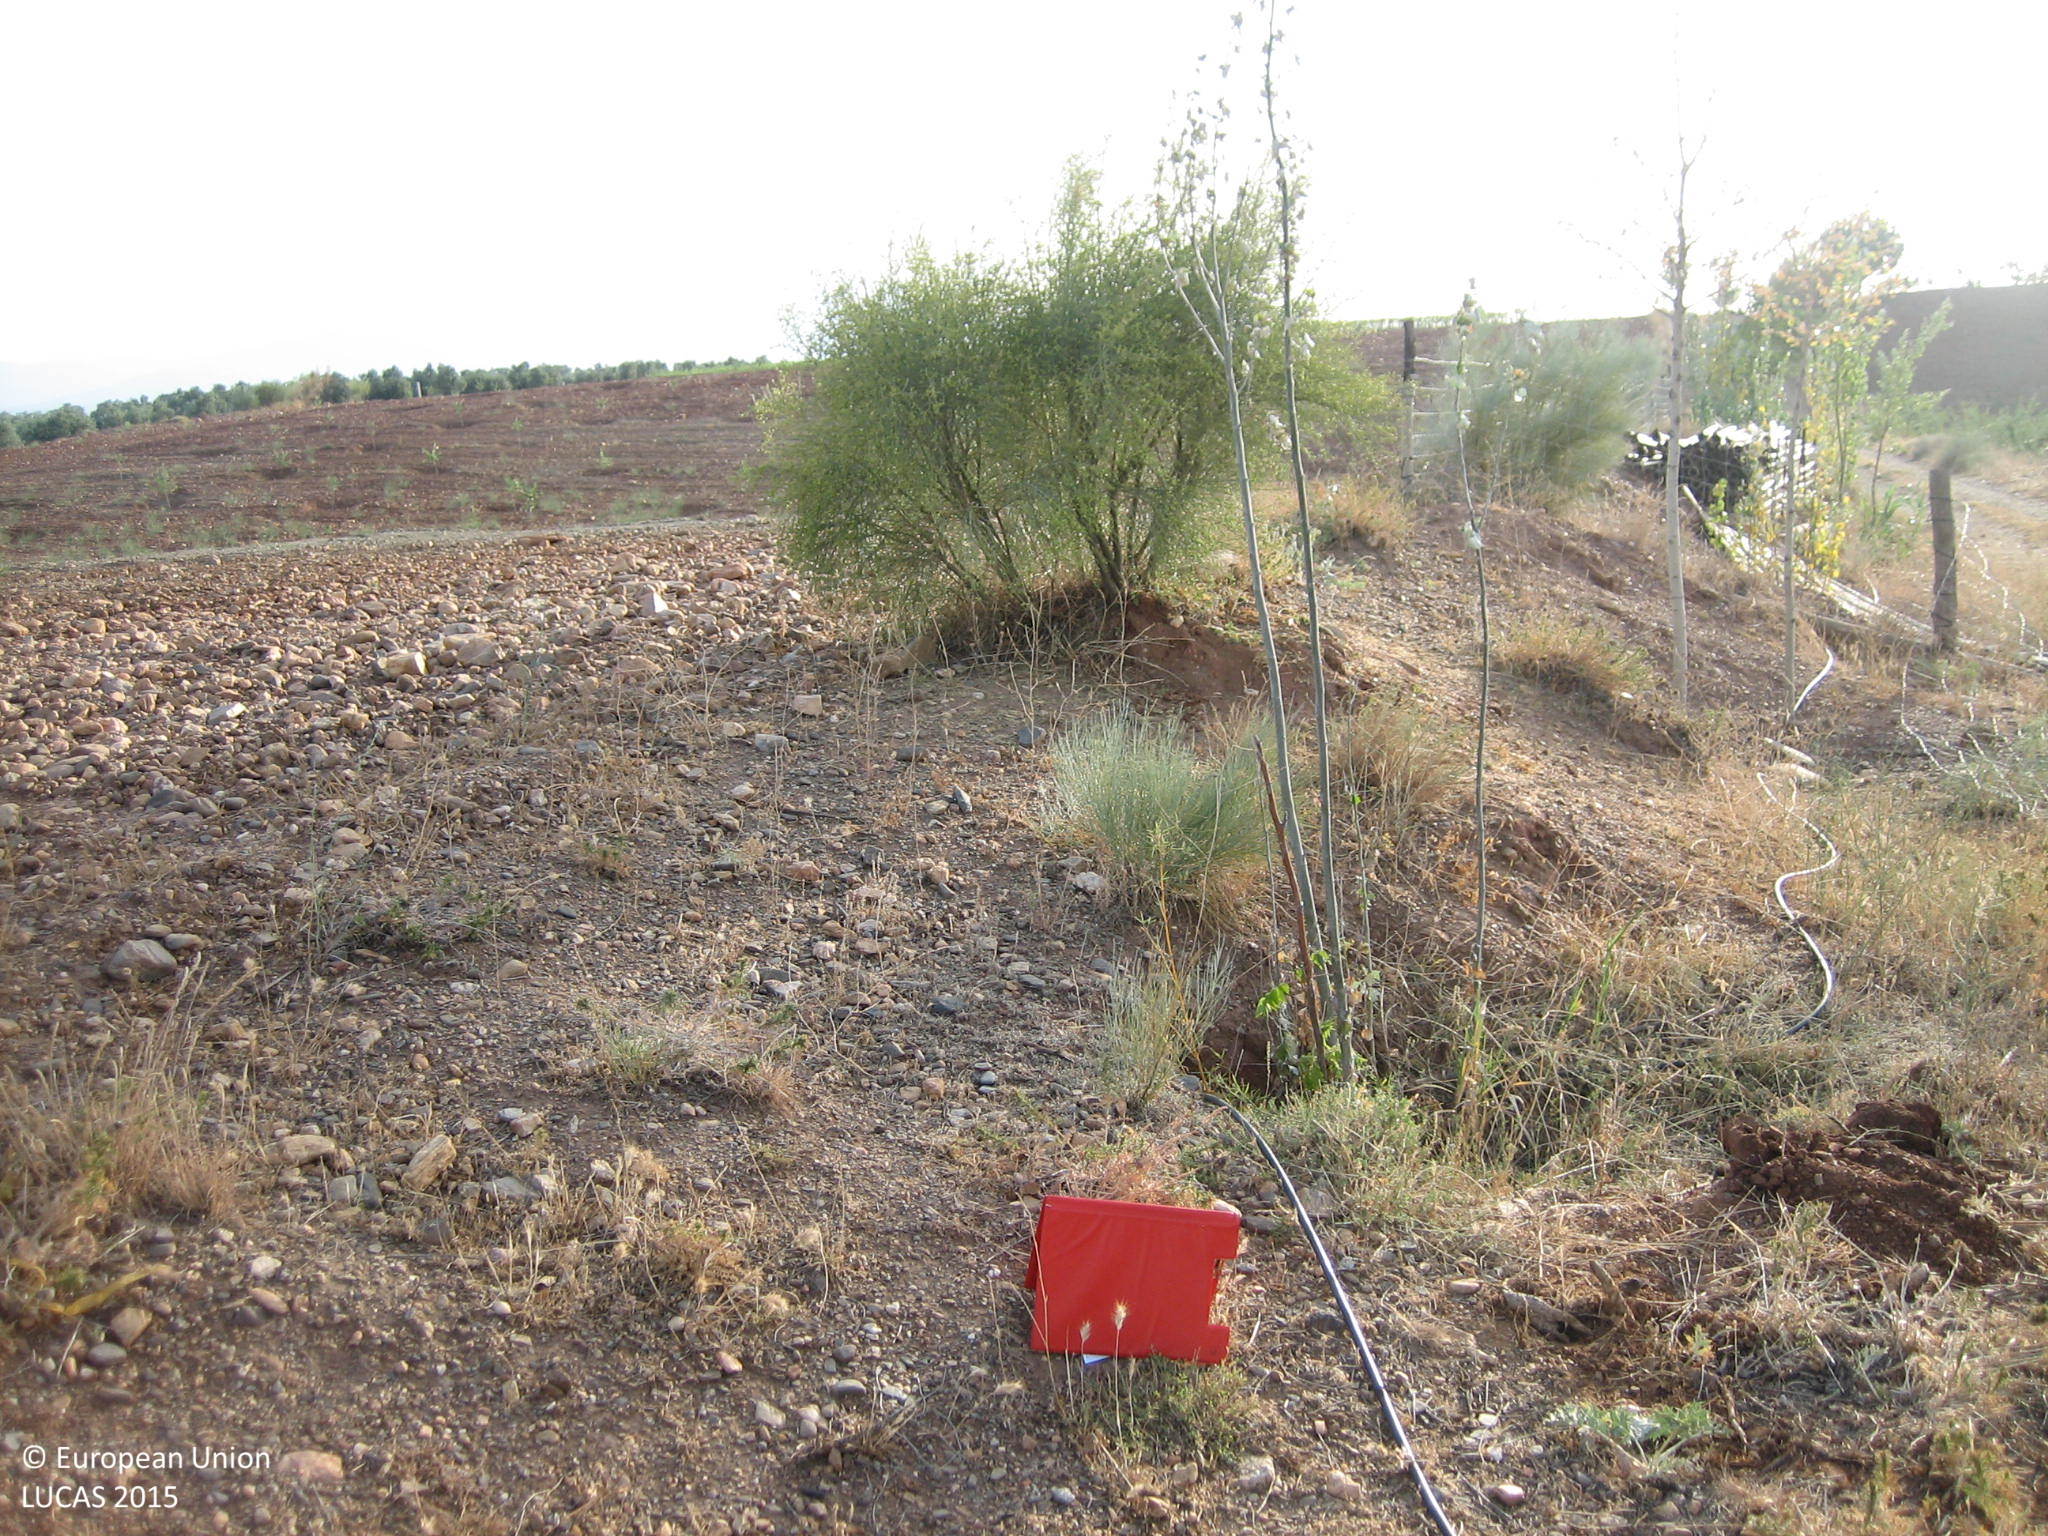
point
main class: Shrubland
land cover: Shrubland with sparse tree cover
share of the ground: 10 - 25 %
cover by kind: consolidated bare surface 85 %, shrubs 10 %, broadleaved forest trees 5 %
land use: Logistics and storage
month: July
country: ES
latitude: 37.4273
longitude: -2.6759
